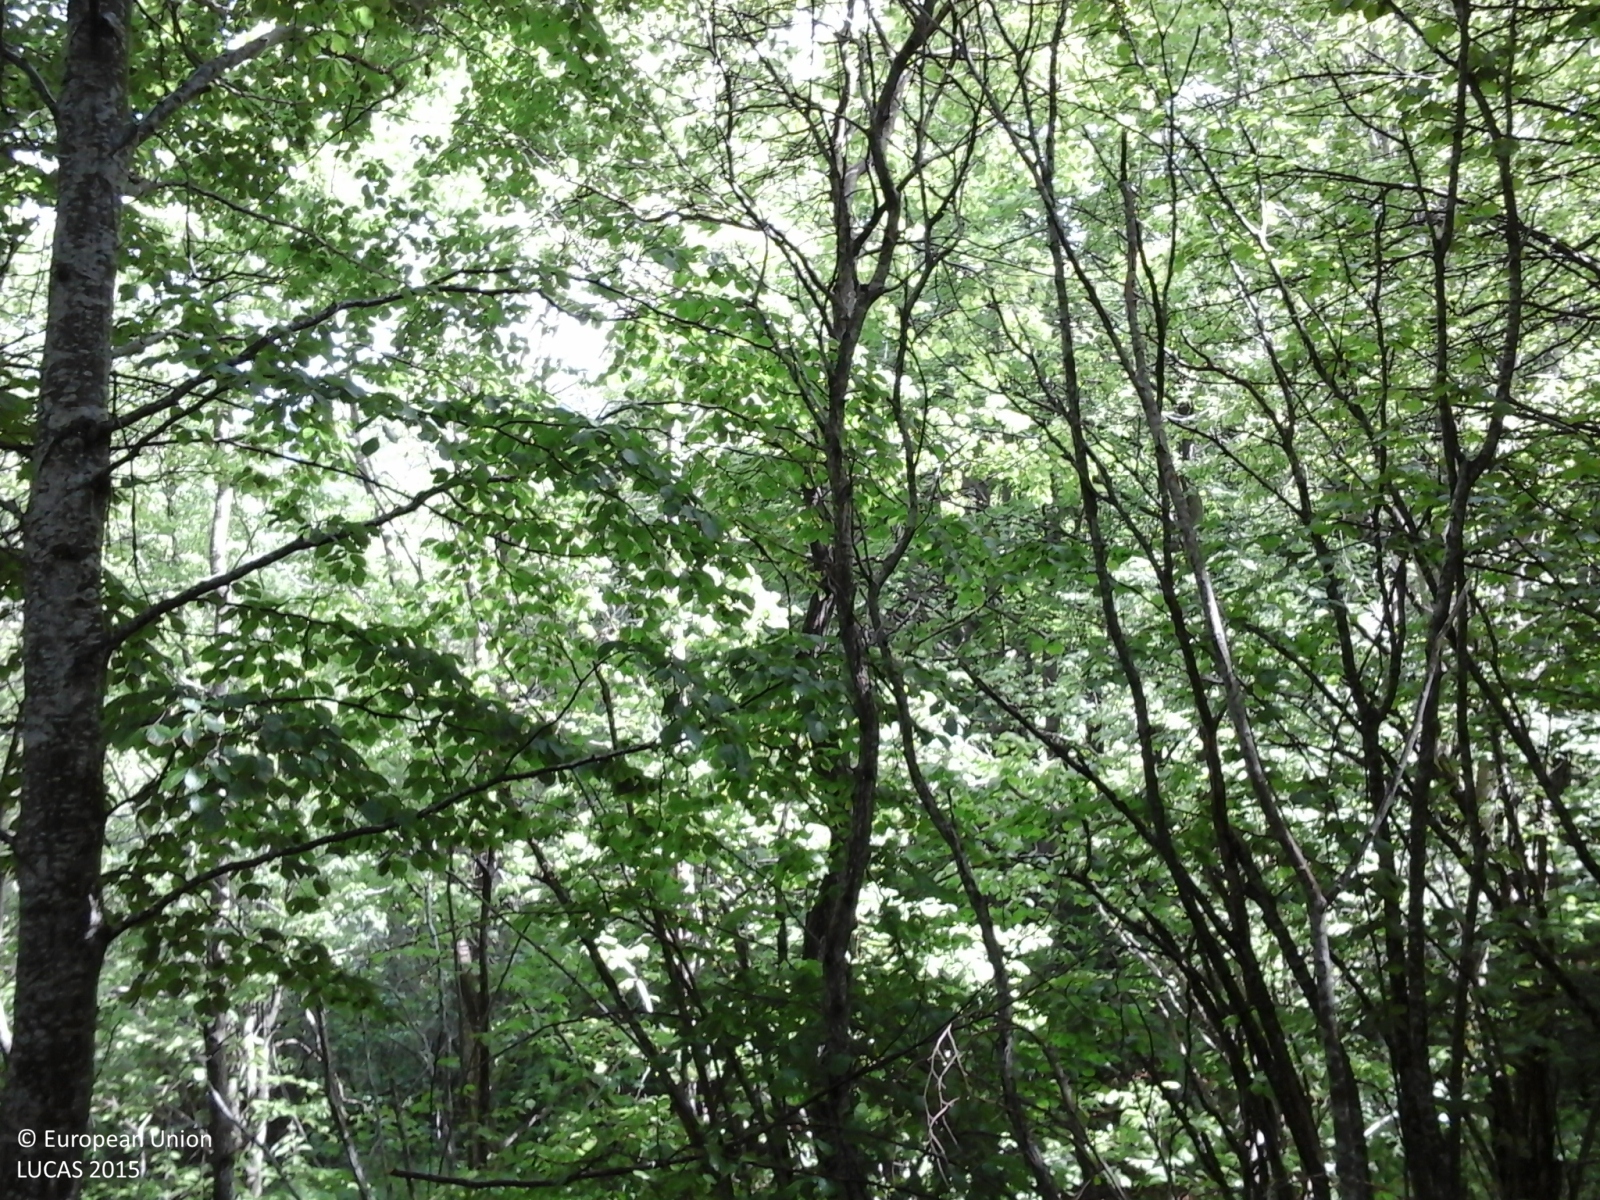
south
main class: Woodland
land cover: Broadleaved woodland
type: mountainous beech forest
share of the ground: > 75 %
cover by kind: broadleaved forest trees 90 %, shrubs 10 %
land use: Forestry
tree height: > 5 m
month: May
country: IT
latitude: 44.4767
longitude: 10.1631
